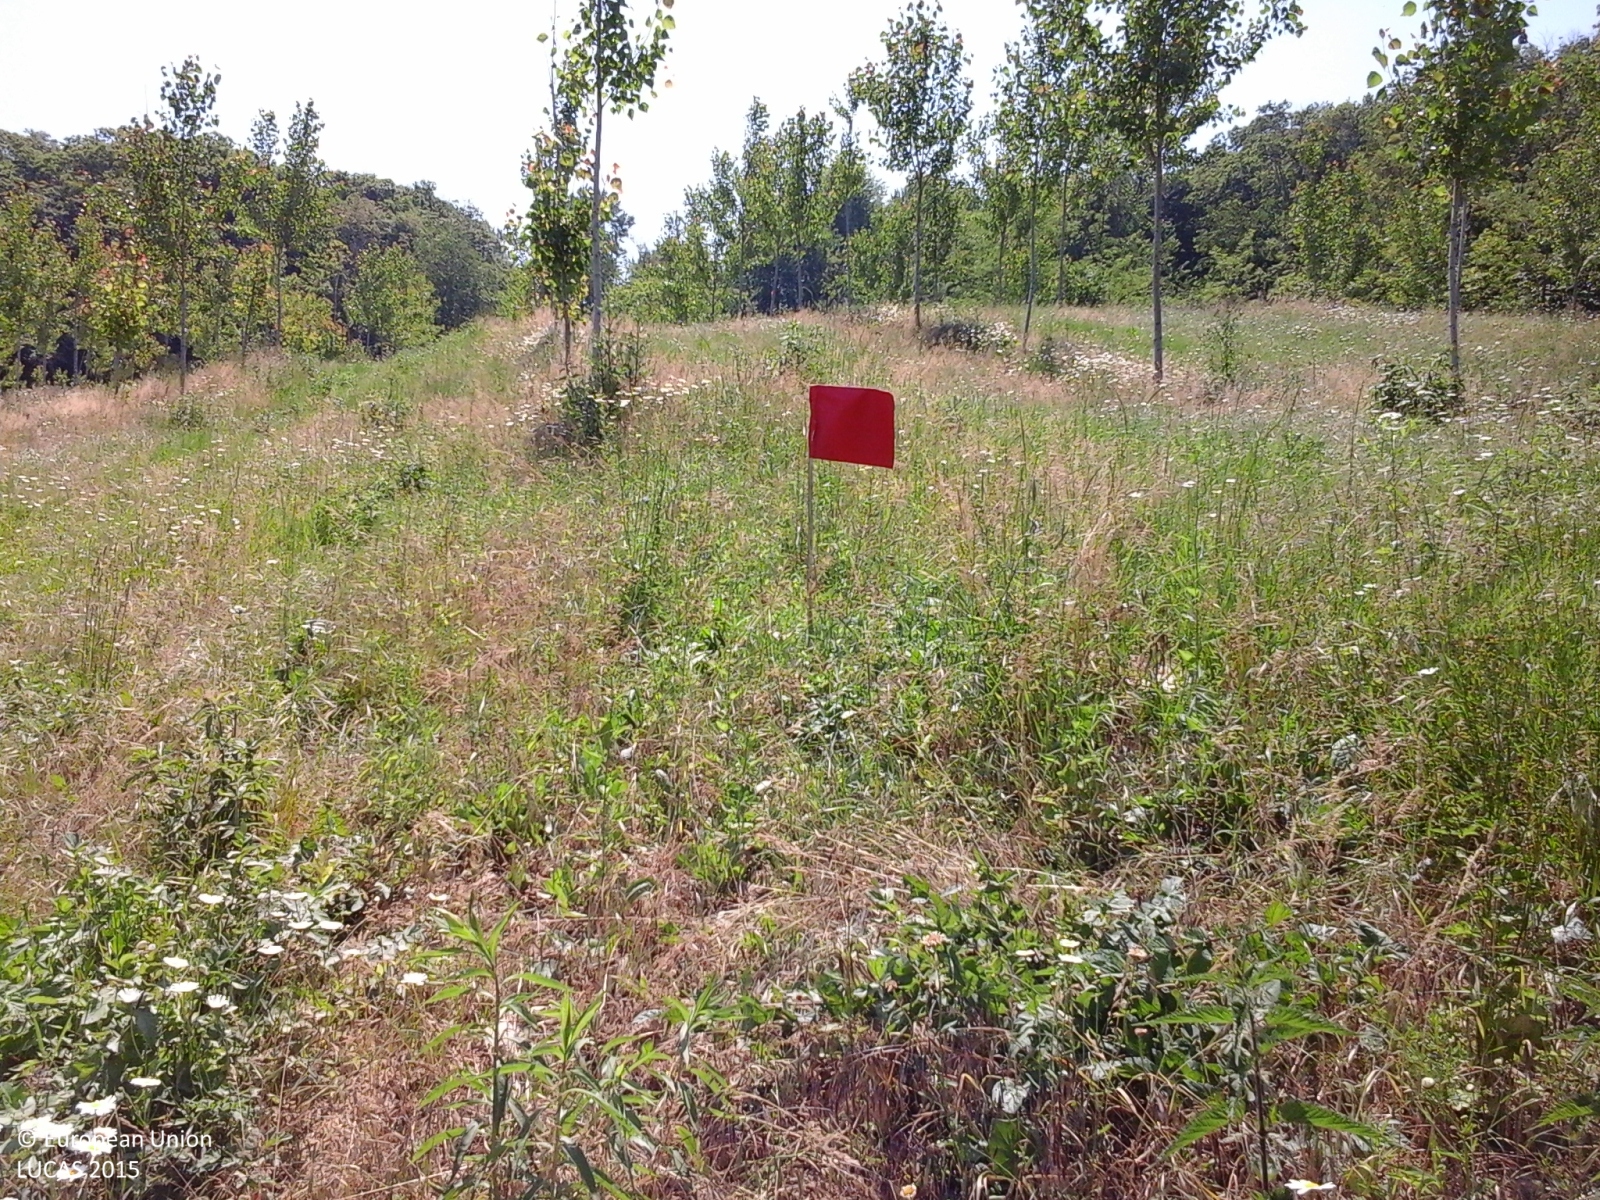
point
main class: Woodland
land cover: Broadleaved woodland
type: non-riverine alder, birch or aspen forest
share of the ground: 25 - 50 %
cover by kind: herbaceous plants 80 %, broadleaved forest trees 20 %
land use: Forestry
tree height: < 5 m
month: June
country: IT
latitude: 44.6781
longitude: 8.2248
